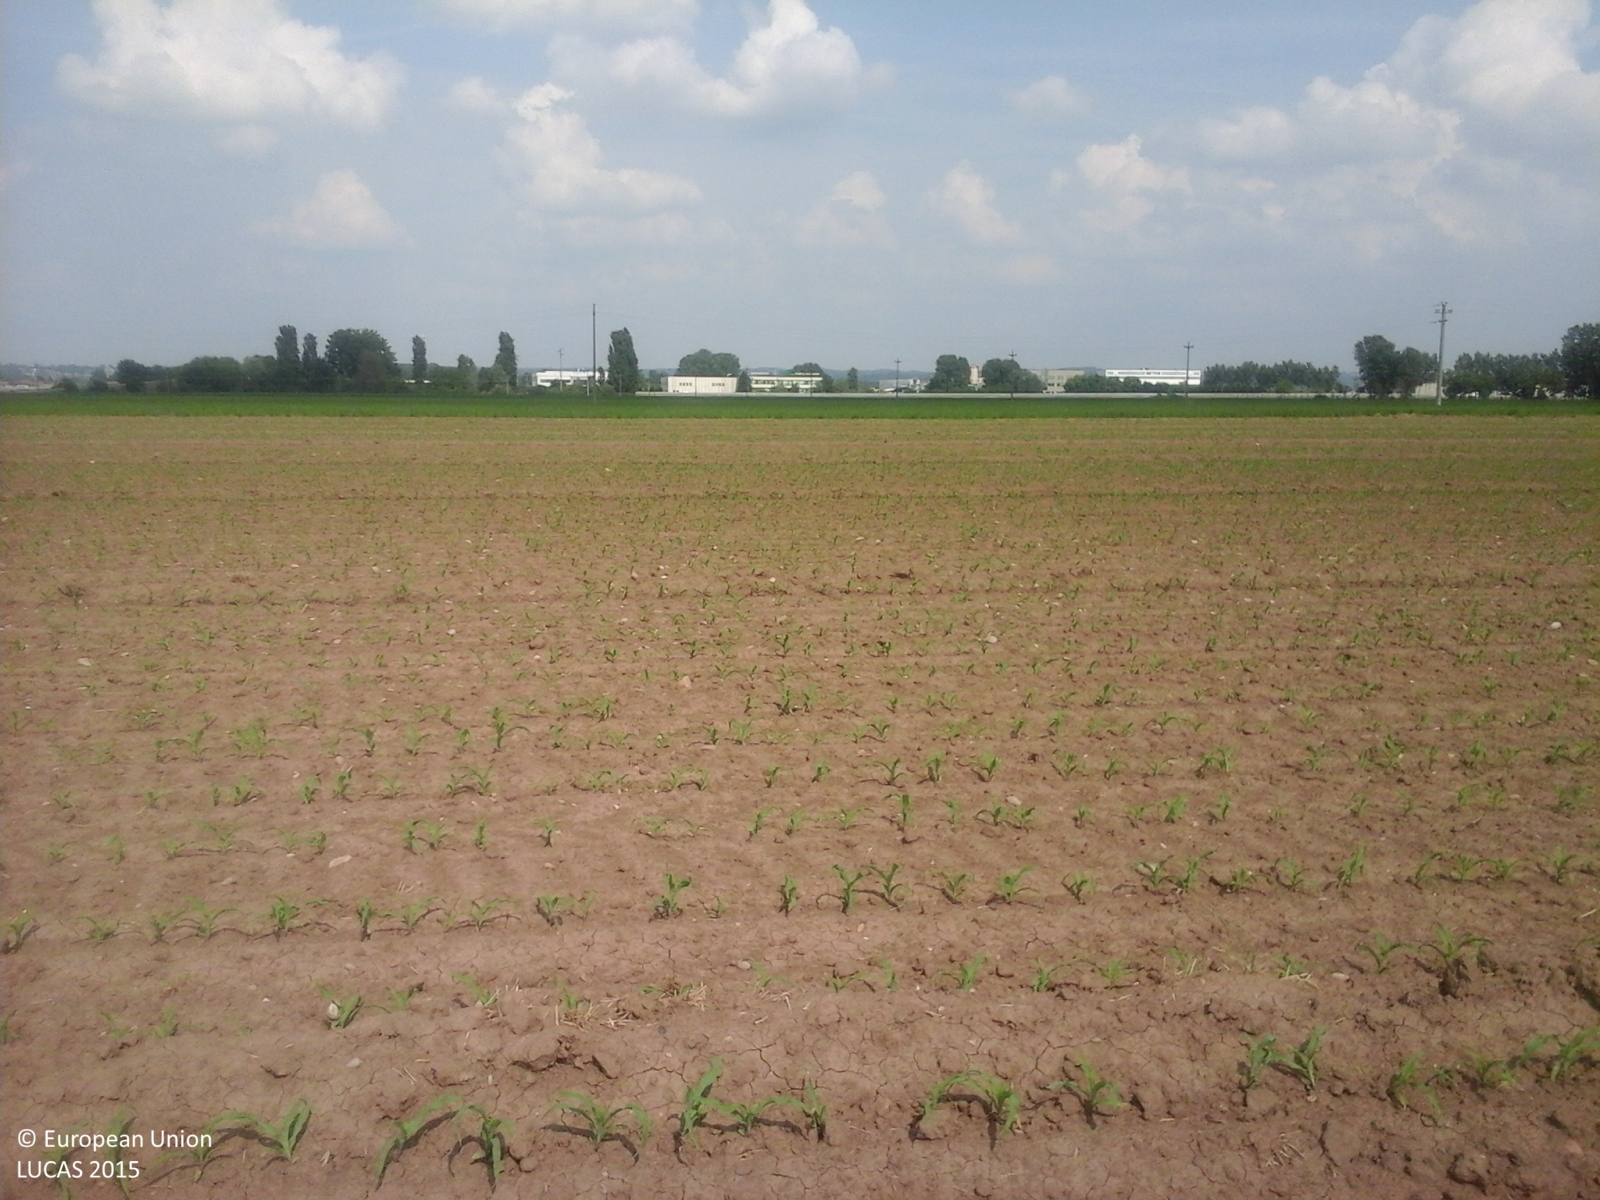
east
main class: Cropland
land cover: Maize
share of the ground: < 10 %
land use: Agriculture (excluding fallow land and kitchen gardens)
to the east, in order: Maize; Temporary grasslands; Electric lines; Temporary grasslands; Ditches and canals; Temporary grasslands
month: June
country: IT
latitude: 44.7410
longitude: 7.7438
